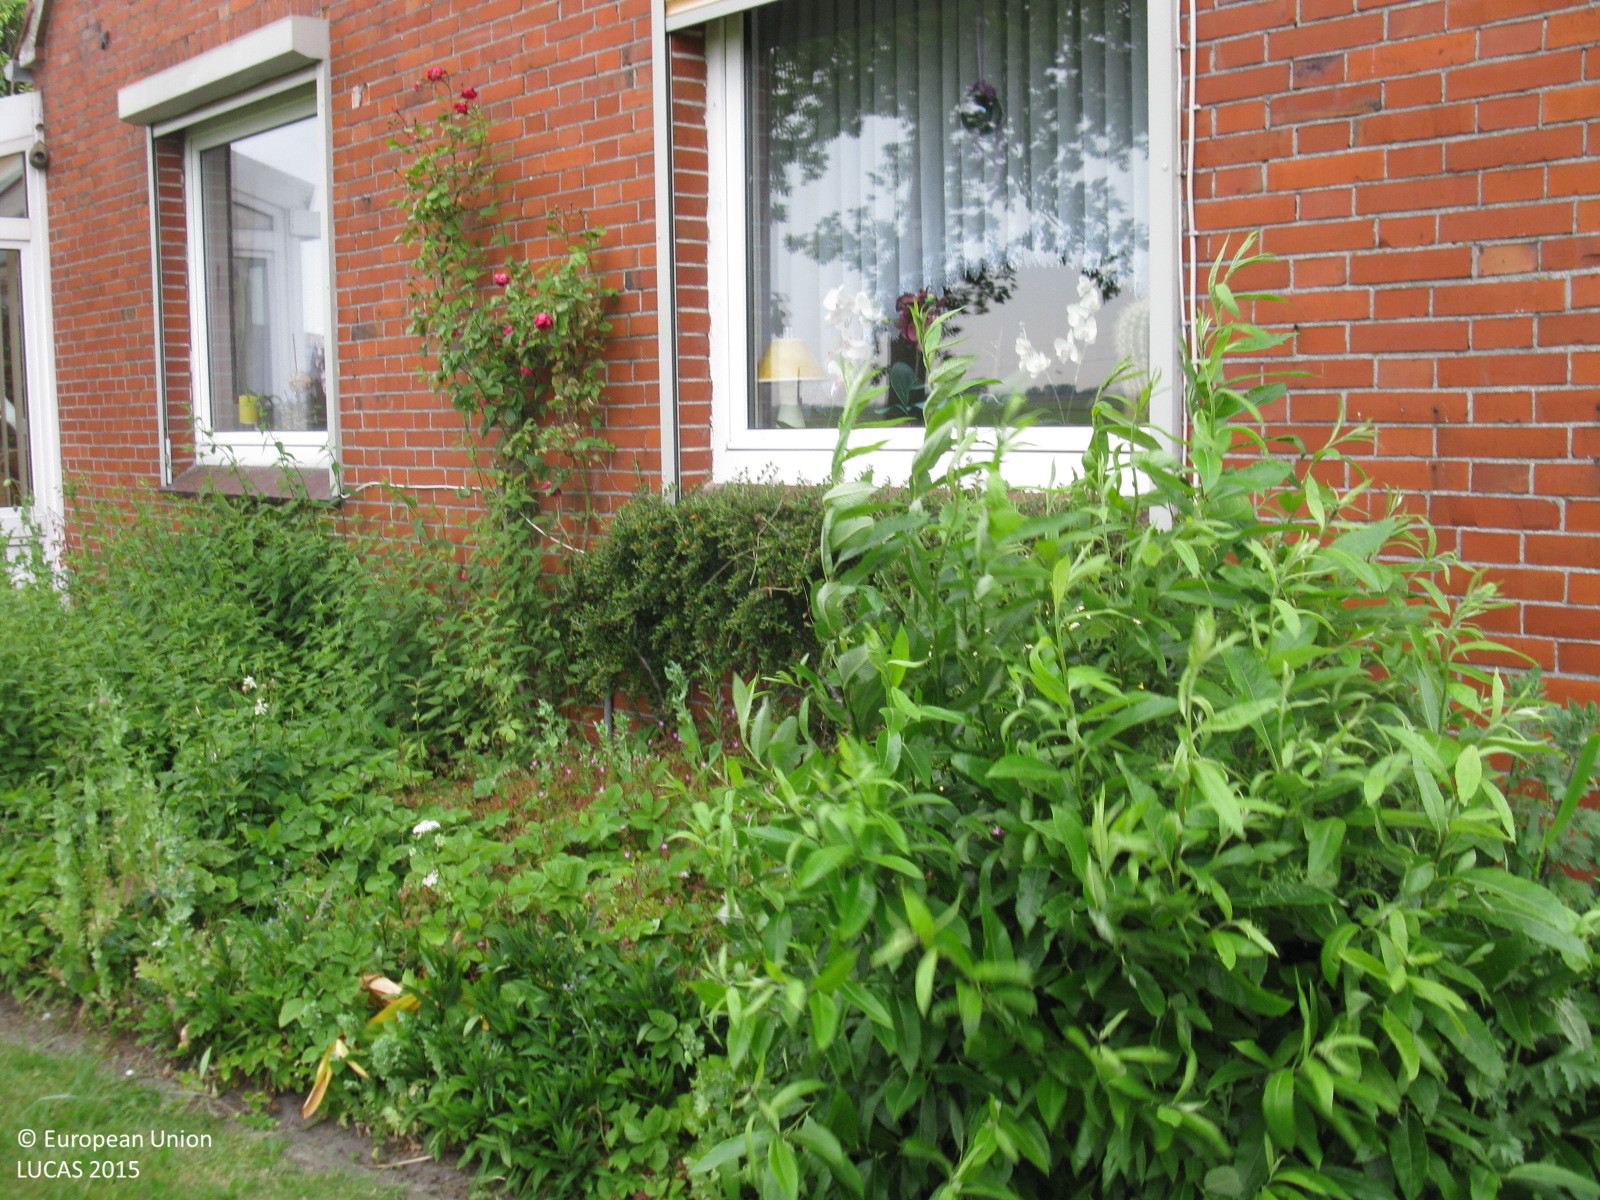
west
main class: Grassland
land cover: Grassland without tree/shrub cover
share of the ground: > 75 %
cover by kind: herbaceous plants 100 %
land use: Residential
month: June
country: DE
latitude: 53.4798
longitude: 7.3034
